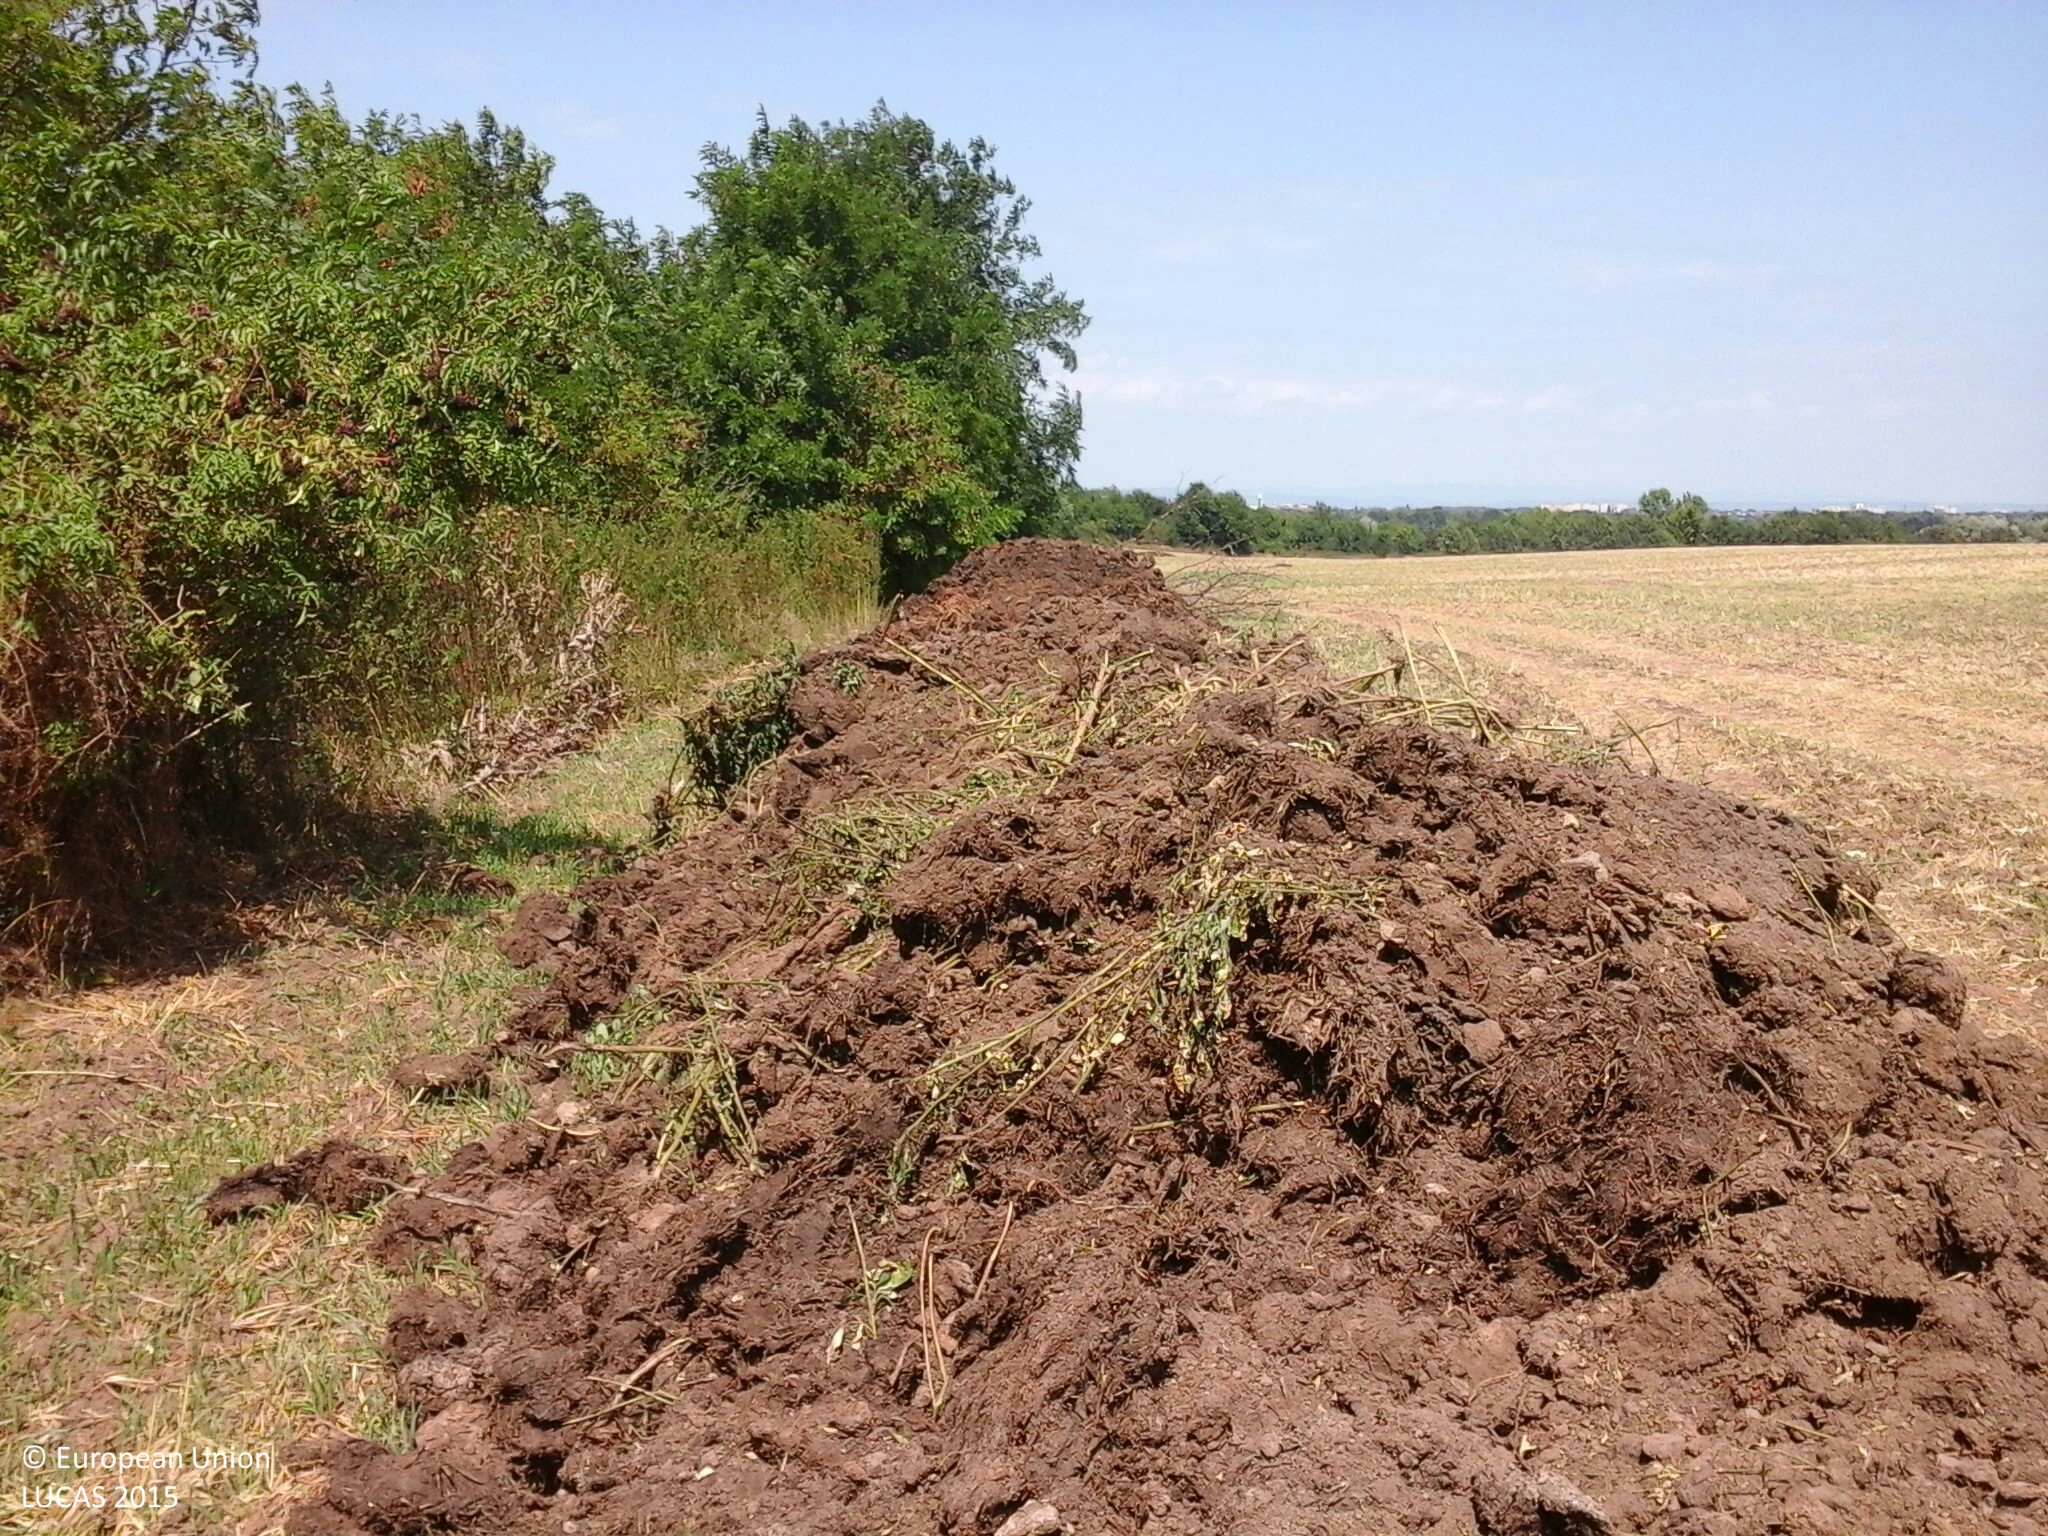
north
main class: Cropland
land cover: Common wheat
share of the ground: > 75 %
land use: Agriculture (excluding fallow land and kitchen gardens)
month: August
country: HU
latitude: 46.8617
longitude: 18.0499
